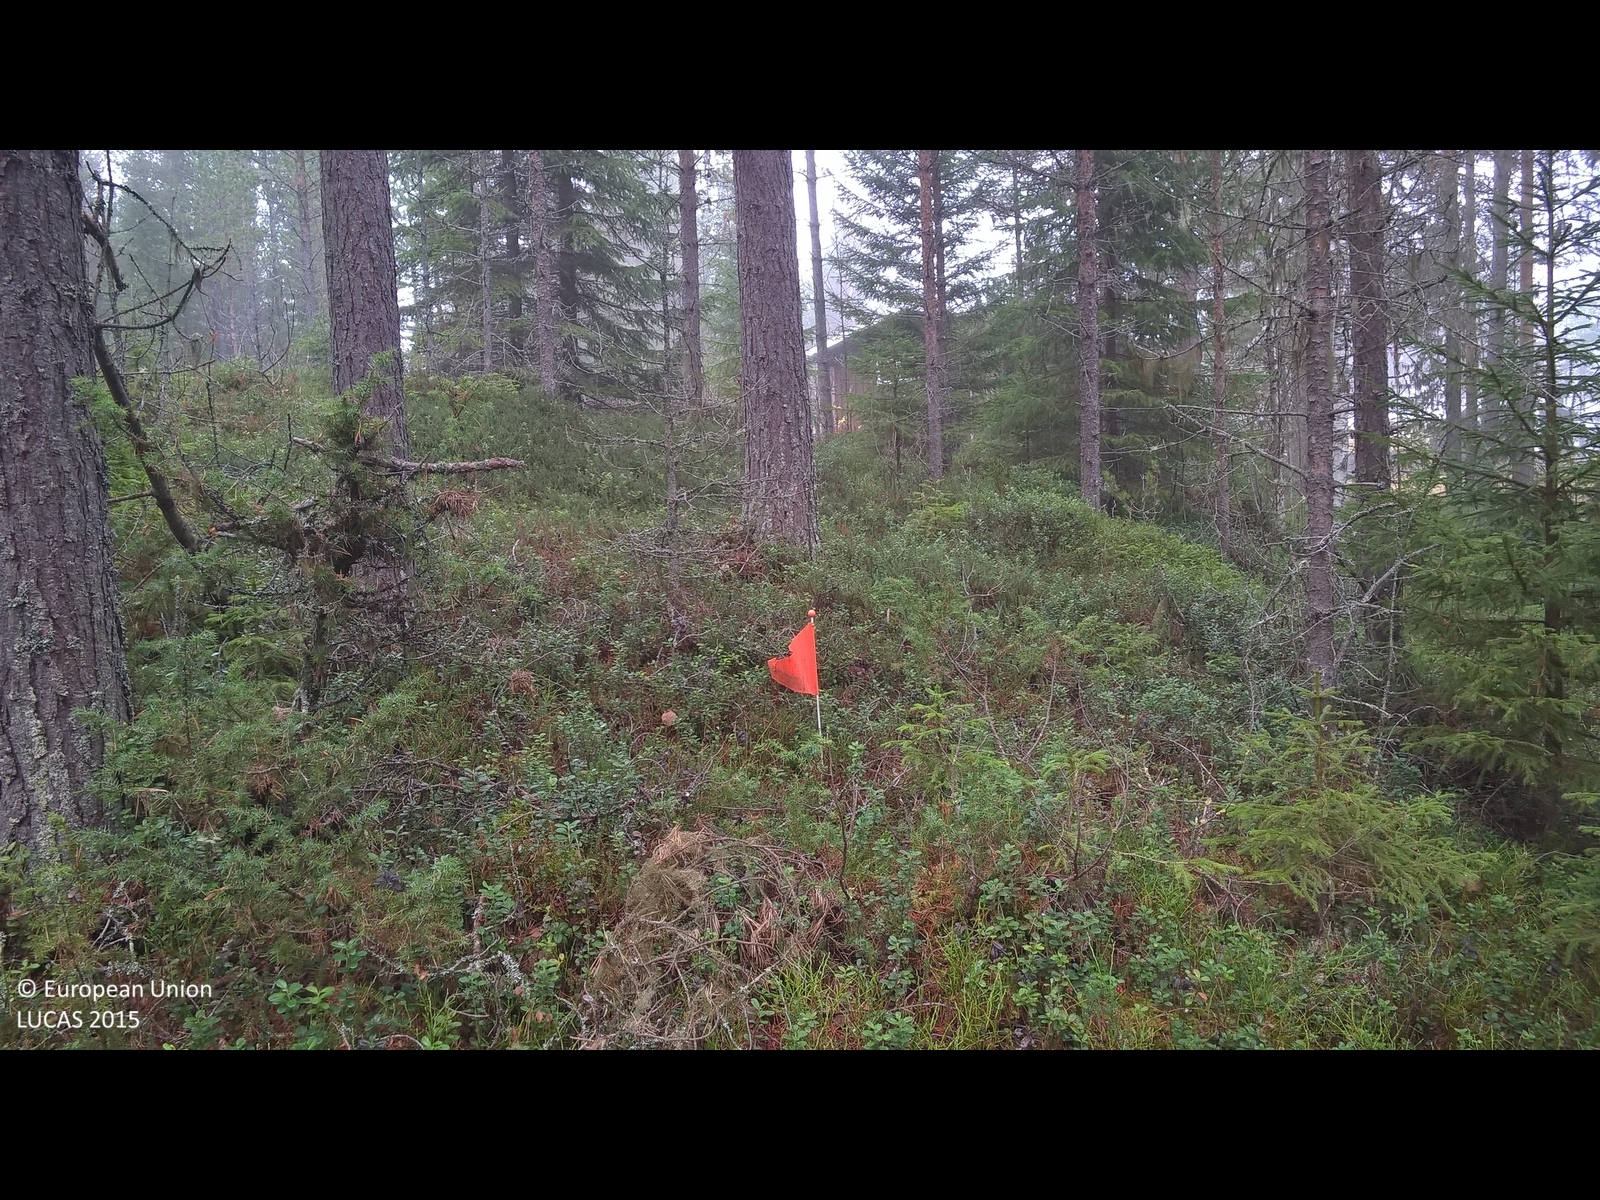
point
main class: Woodland
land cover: Pine dominated coniferous woodland
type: boreal forest
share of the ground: > 75 %
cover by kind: coniferous forest trees 65 %, lichens and mosses 20 %, broadleaved forest trees 10 %, herbaceous plants 5 %
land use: Forestry
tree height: > 5 m
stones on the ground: < 10 %
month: November
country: SE
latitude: 63.2658
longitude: 13.9060
